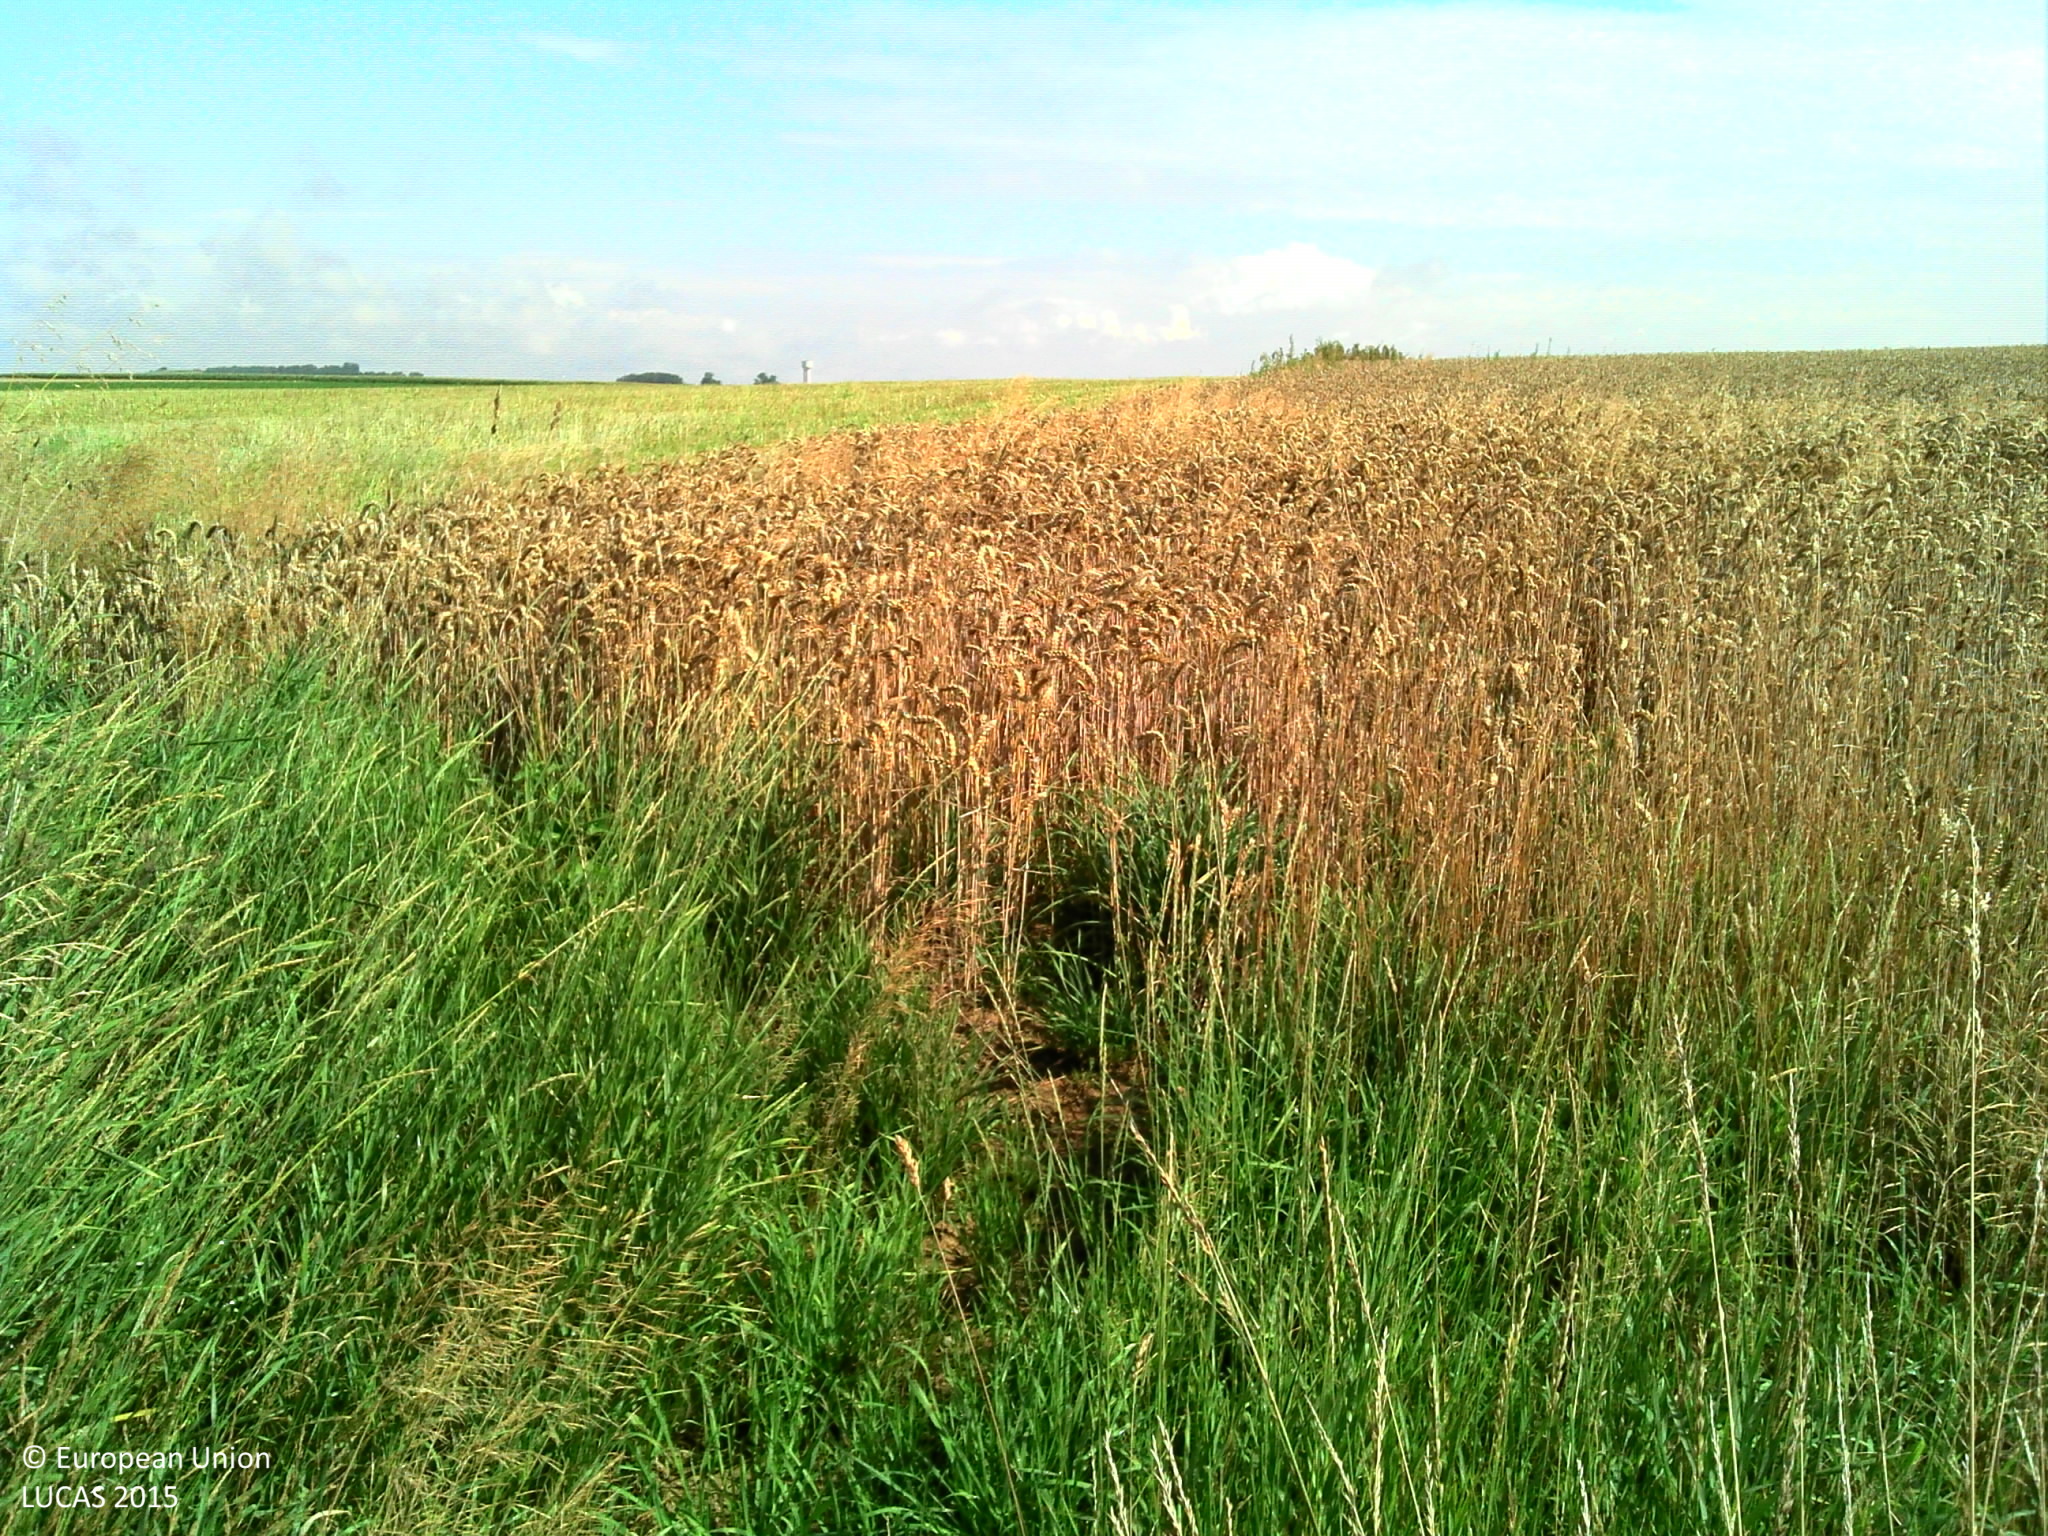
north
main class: Grassland
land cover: Grassland without tree/shrub cover
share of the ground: > 75 %
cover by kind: herbaceous plants 100 %
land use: Agriculture (excluding fallow land and kitchen gardens)
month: July
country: FR
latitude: 50.2934
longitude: 3.6060
